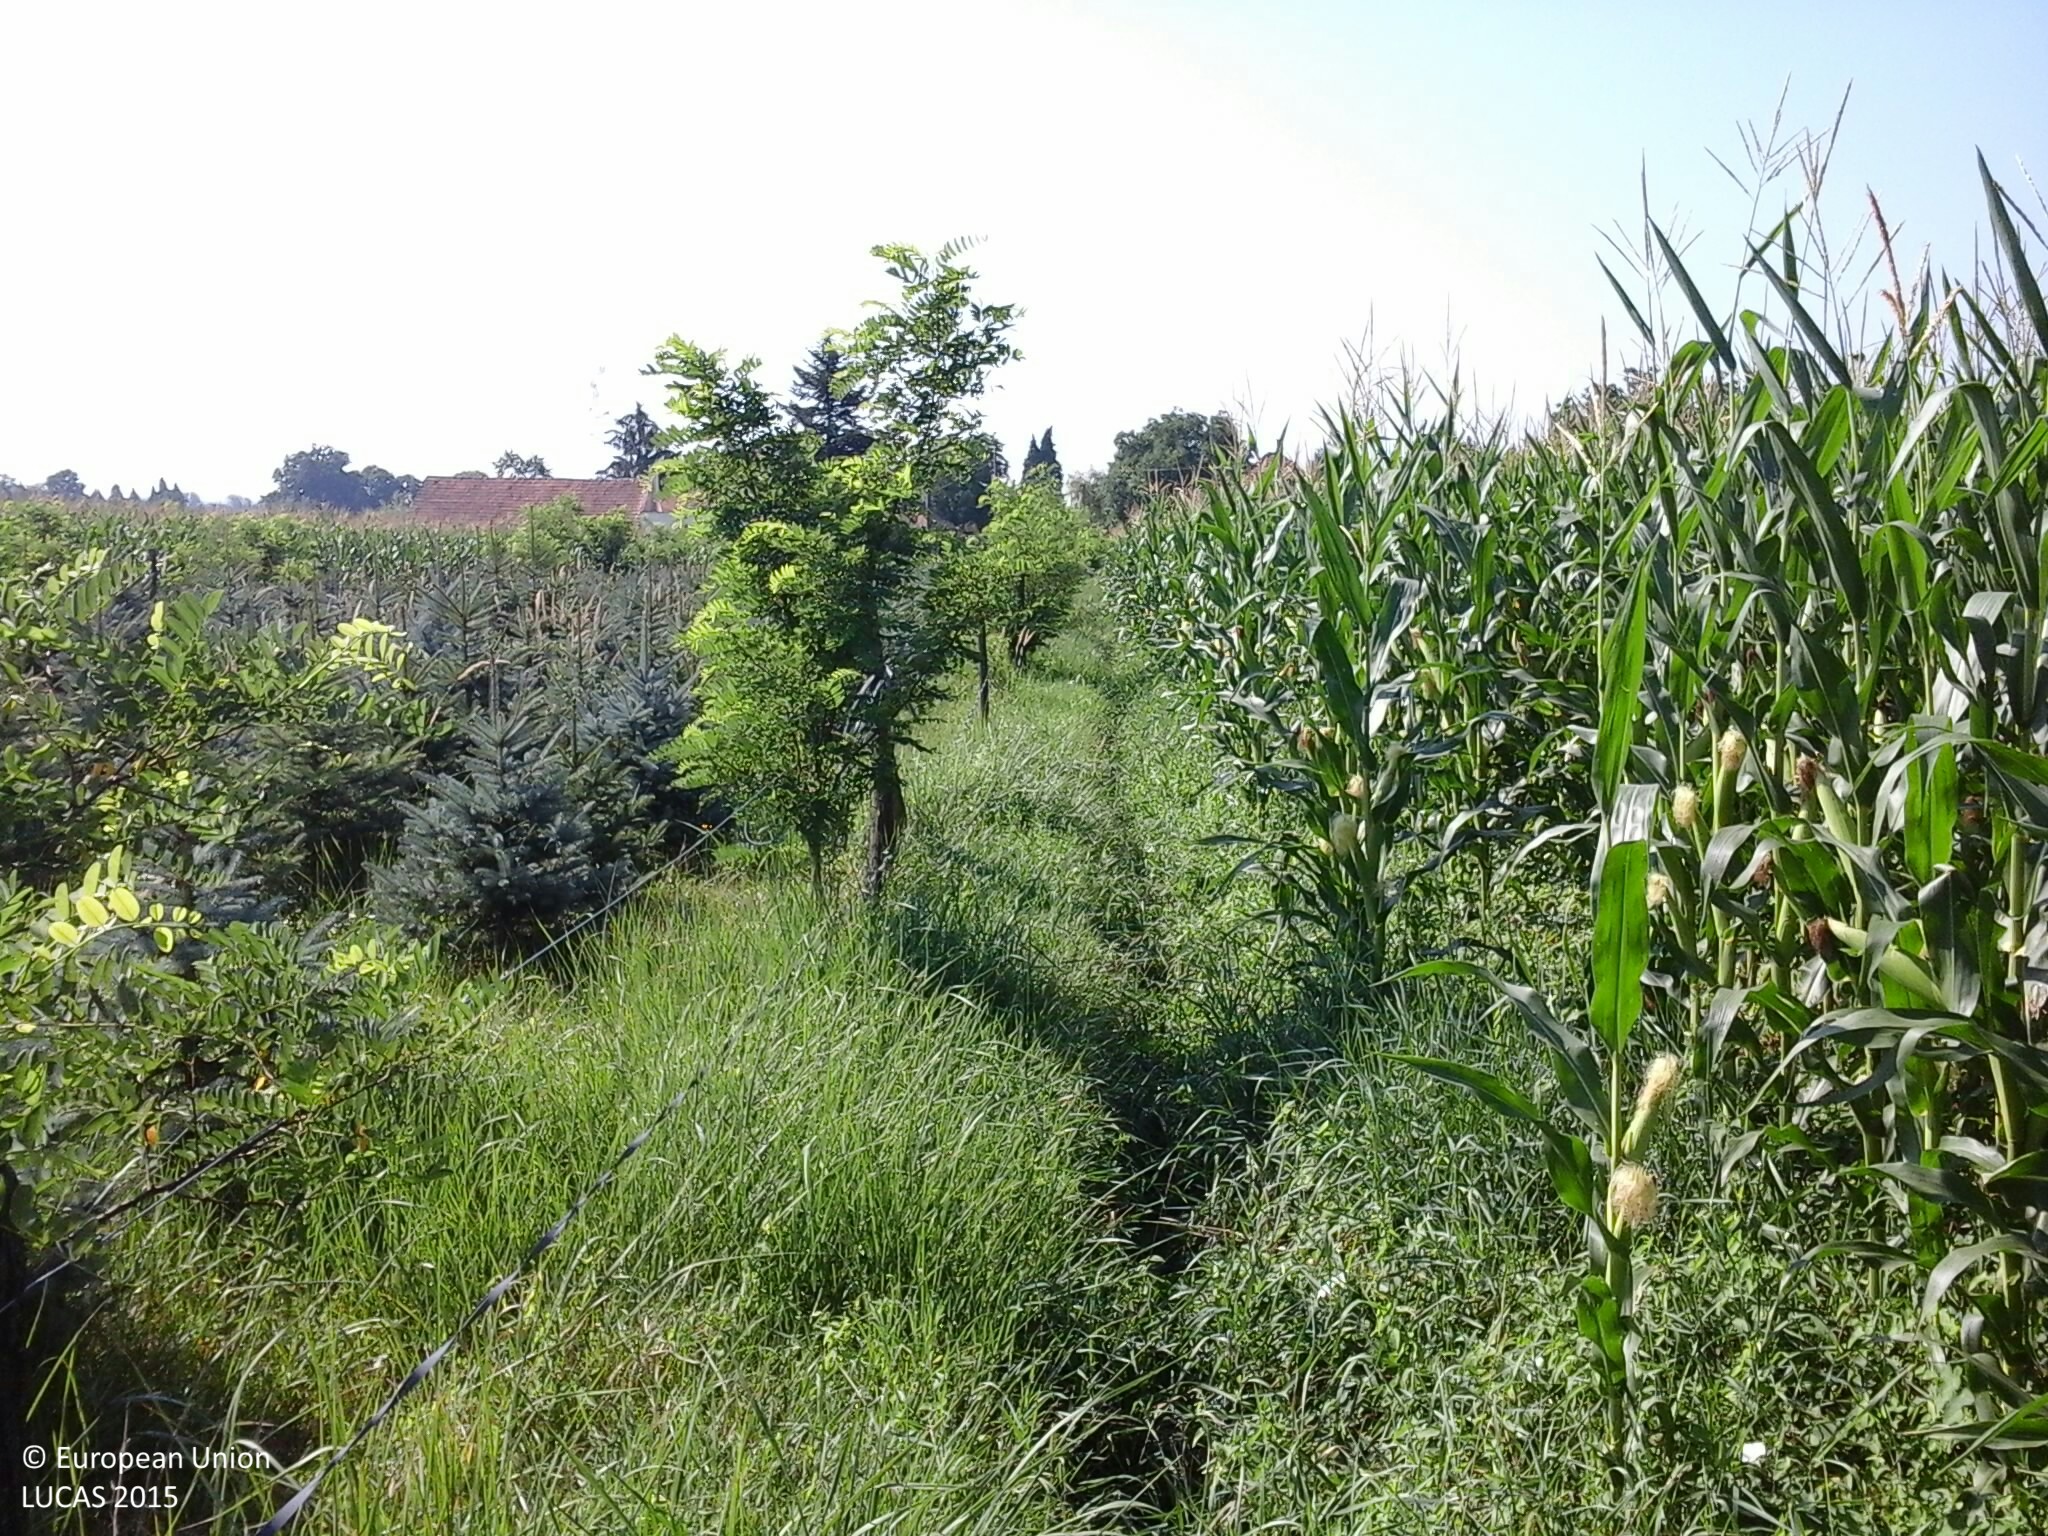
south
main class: Cropland
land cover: Maize
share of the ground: > 75 %
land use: Agriculture (excluding fallow land and kitchen gardens)
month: July
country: HU
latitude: 46.9690
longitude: 16.4558
